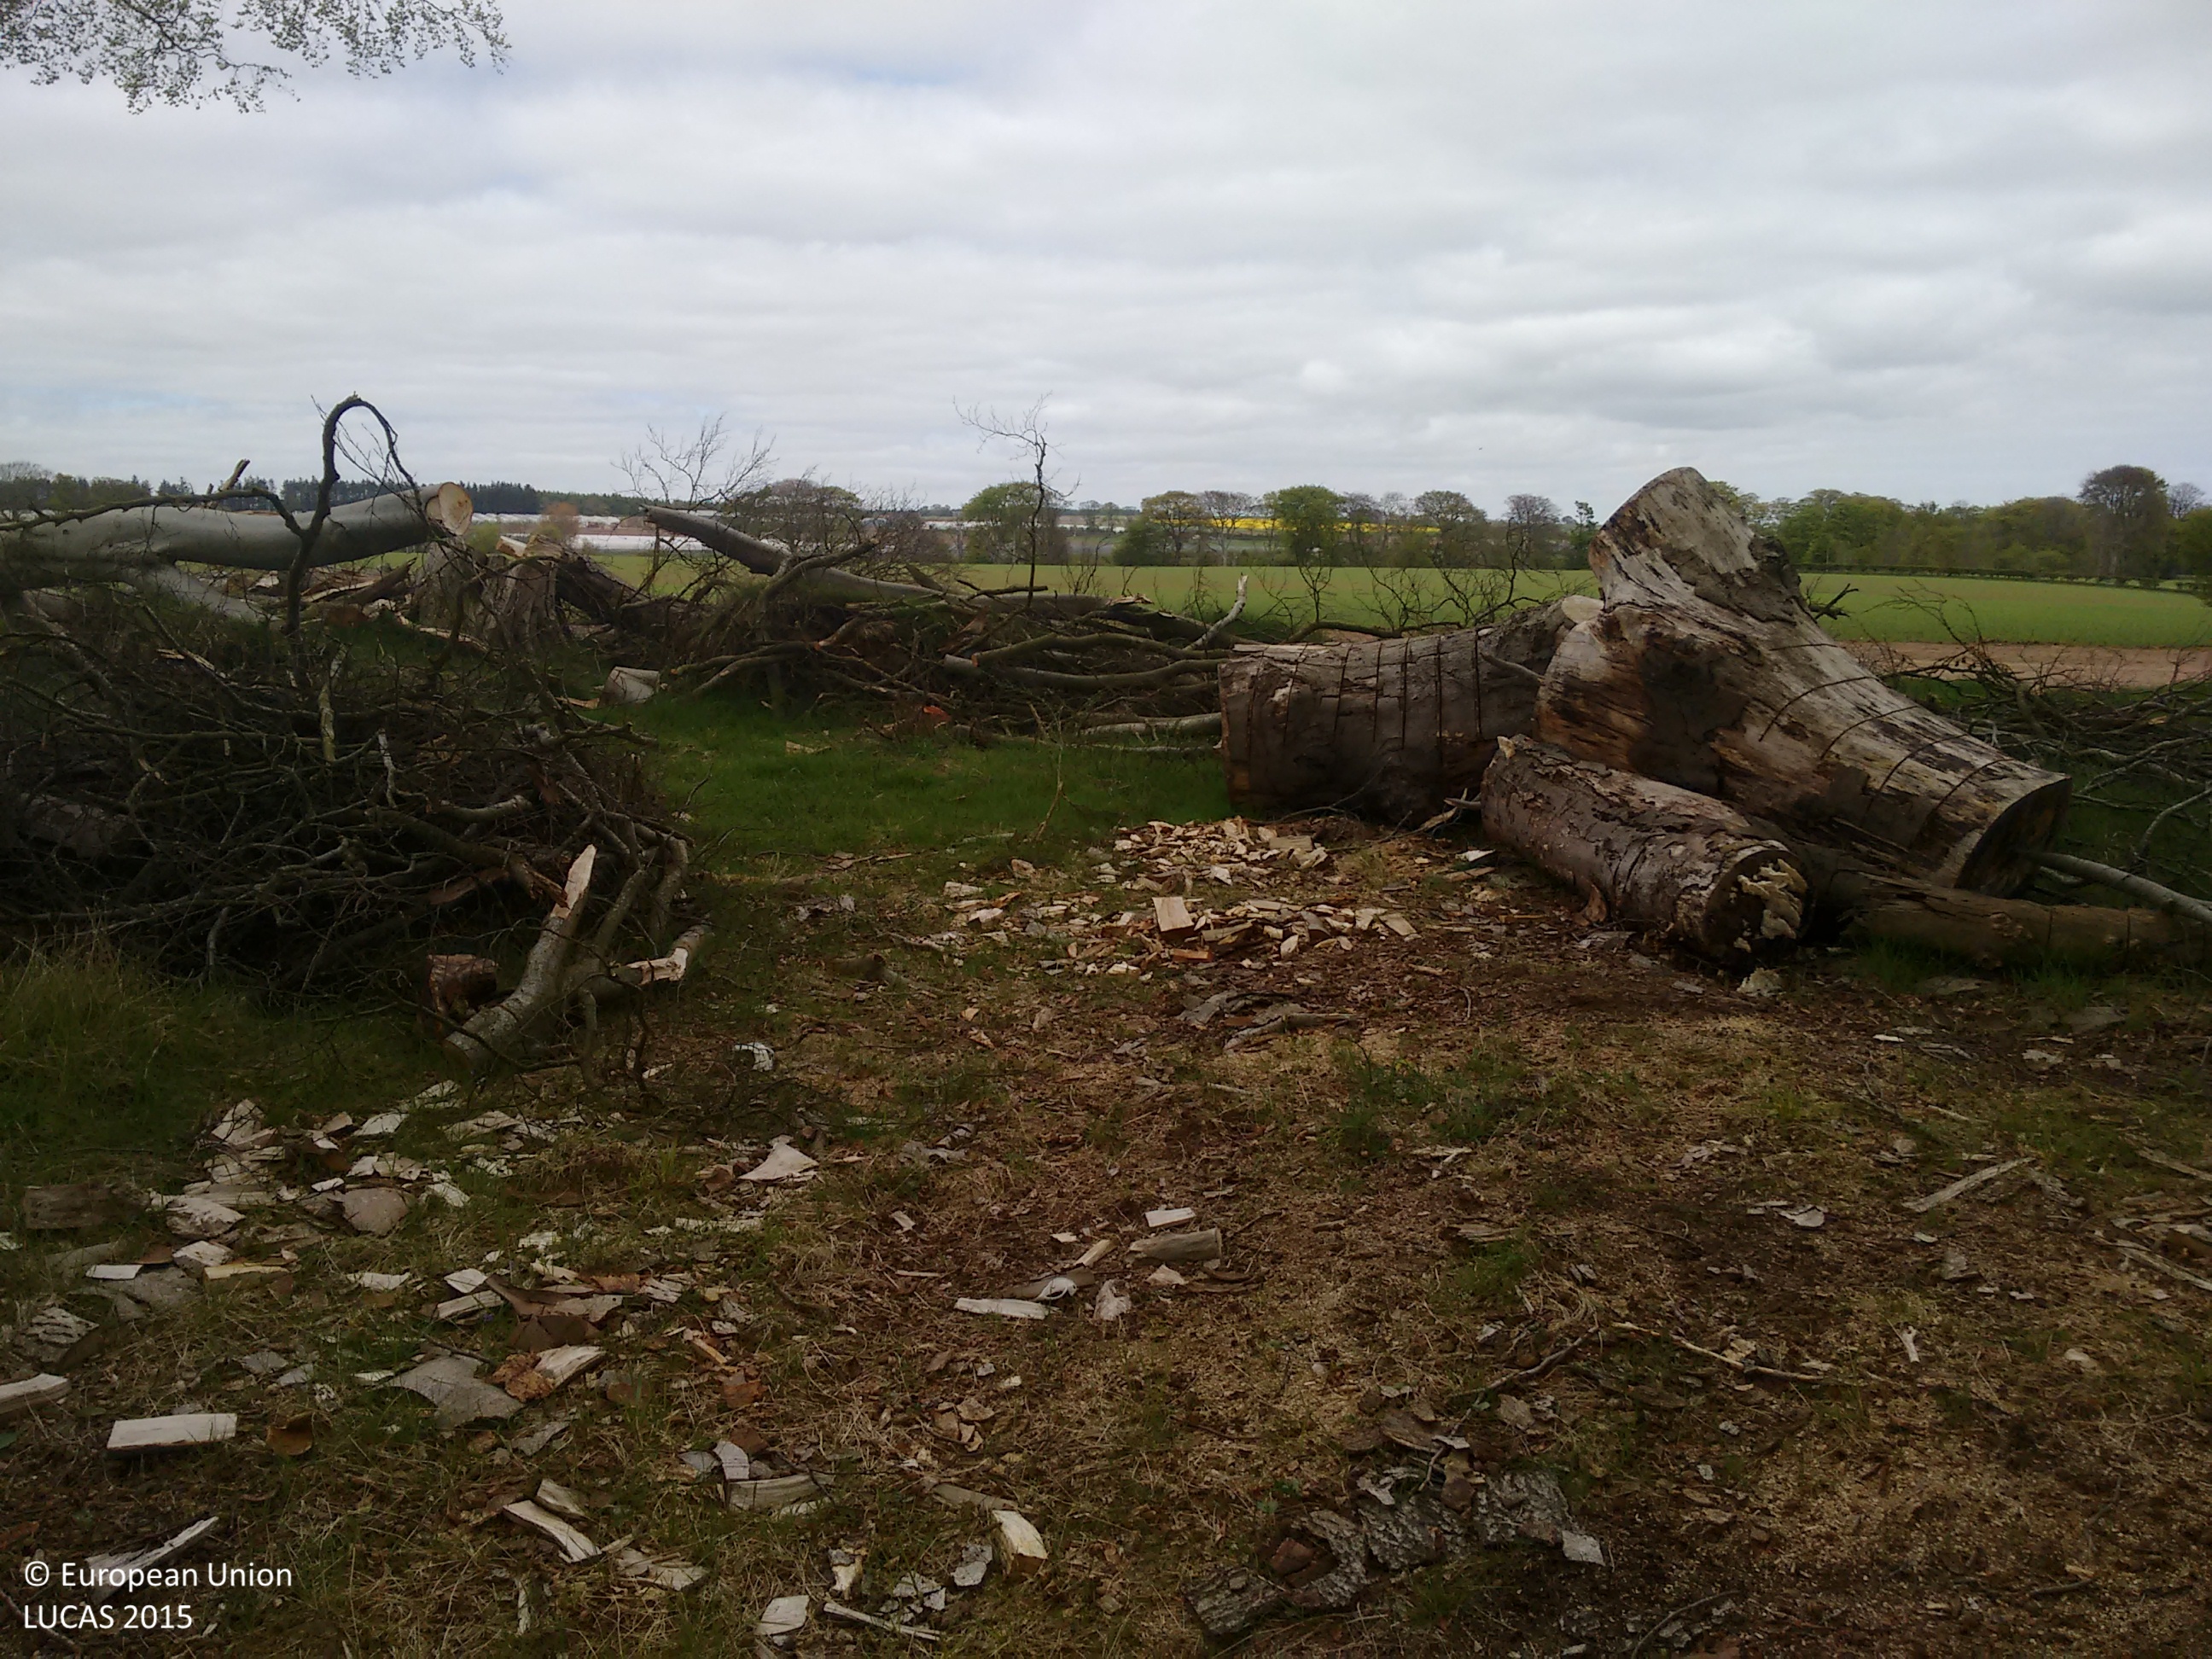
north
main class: Woodland
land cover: Broadleaved woodland
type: exotic forest
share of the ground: > 75 %
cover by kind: broadleaved forest trees 75 %, herbaceous plants 25 %
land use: Semi-natural and natural areas not in use
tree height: > 5 m
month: May
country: GB
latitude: 56.5174
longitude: -2.7218
